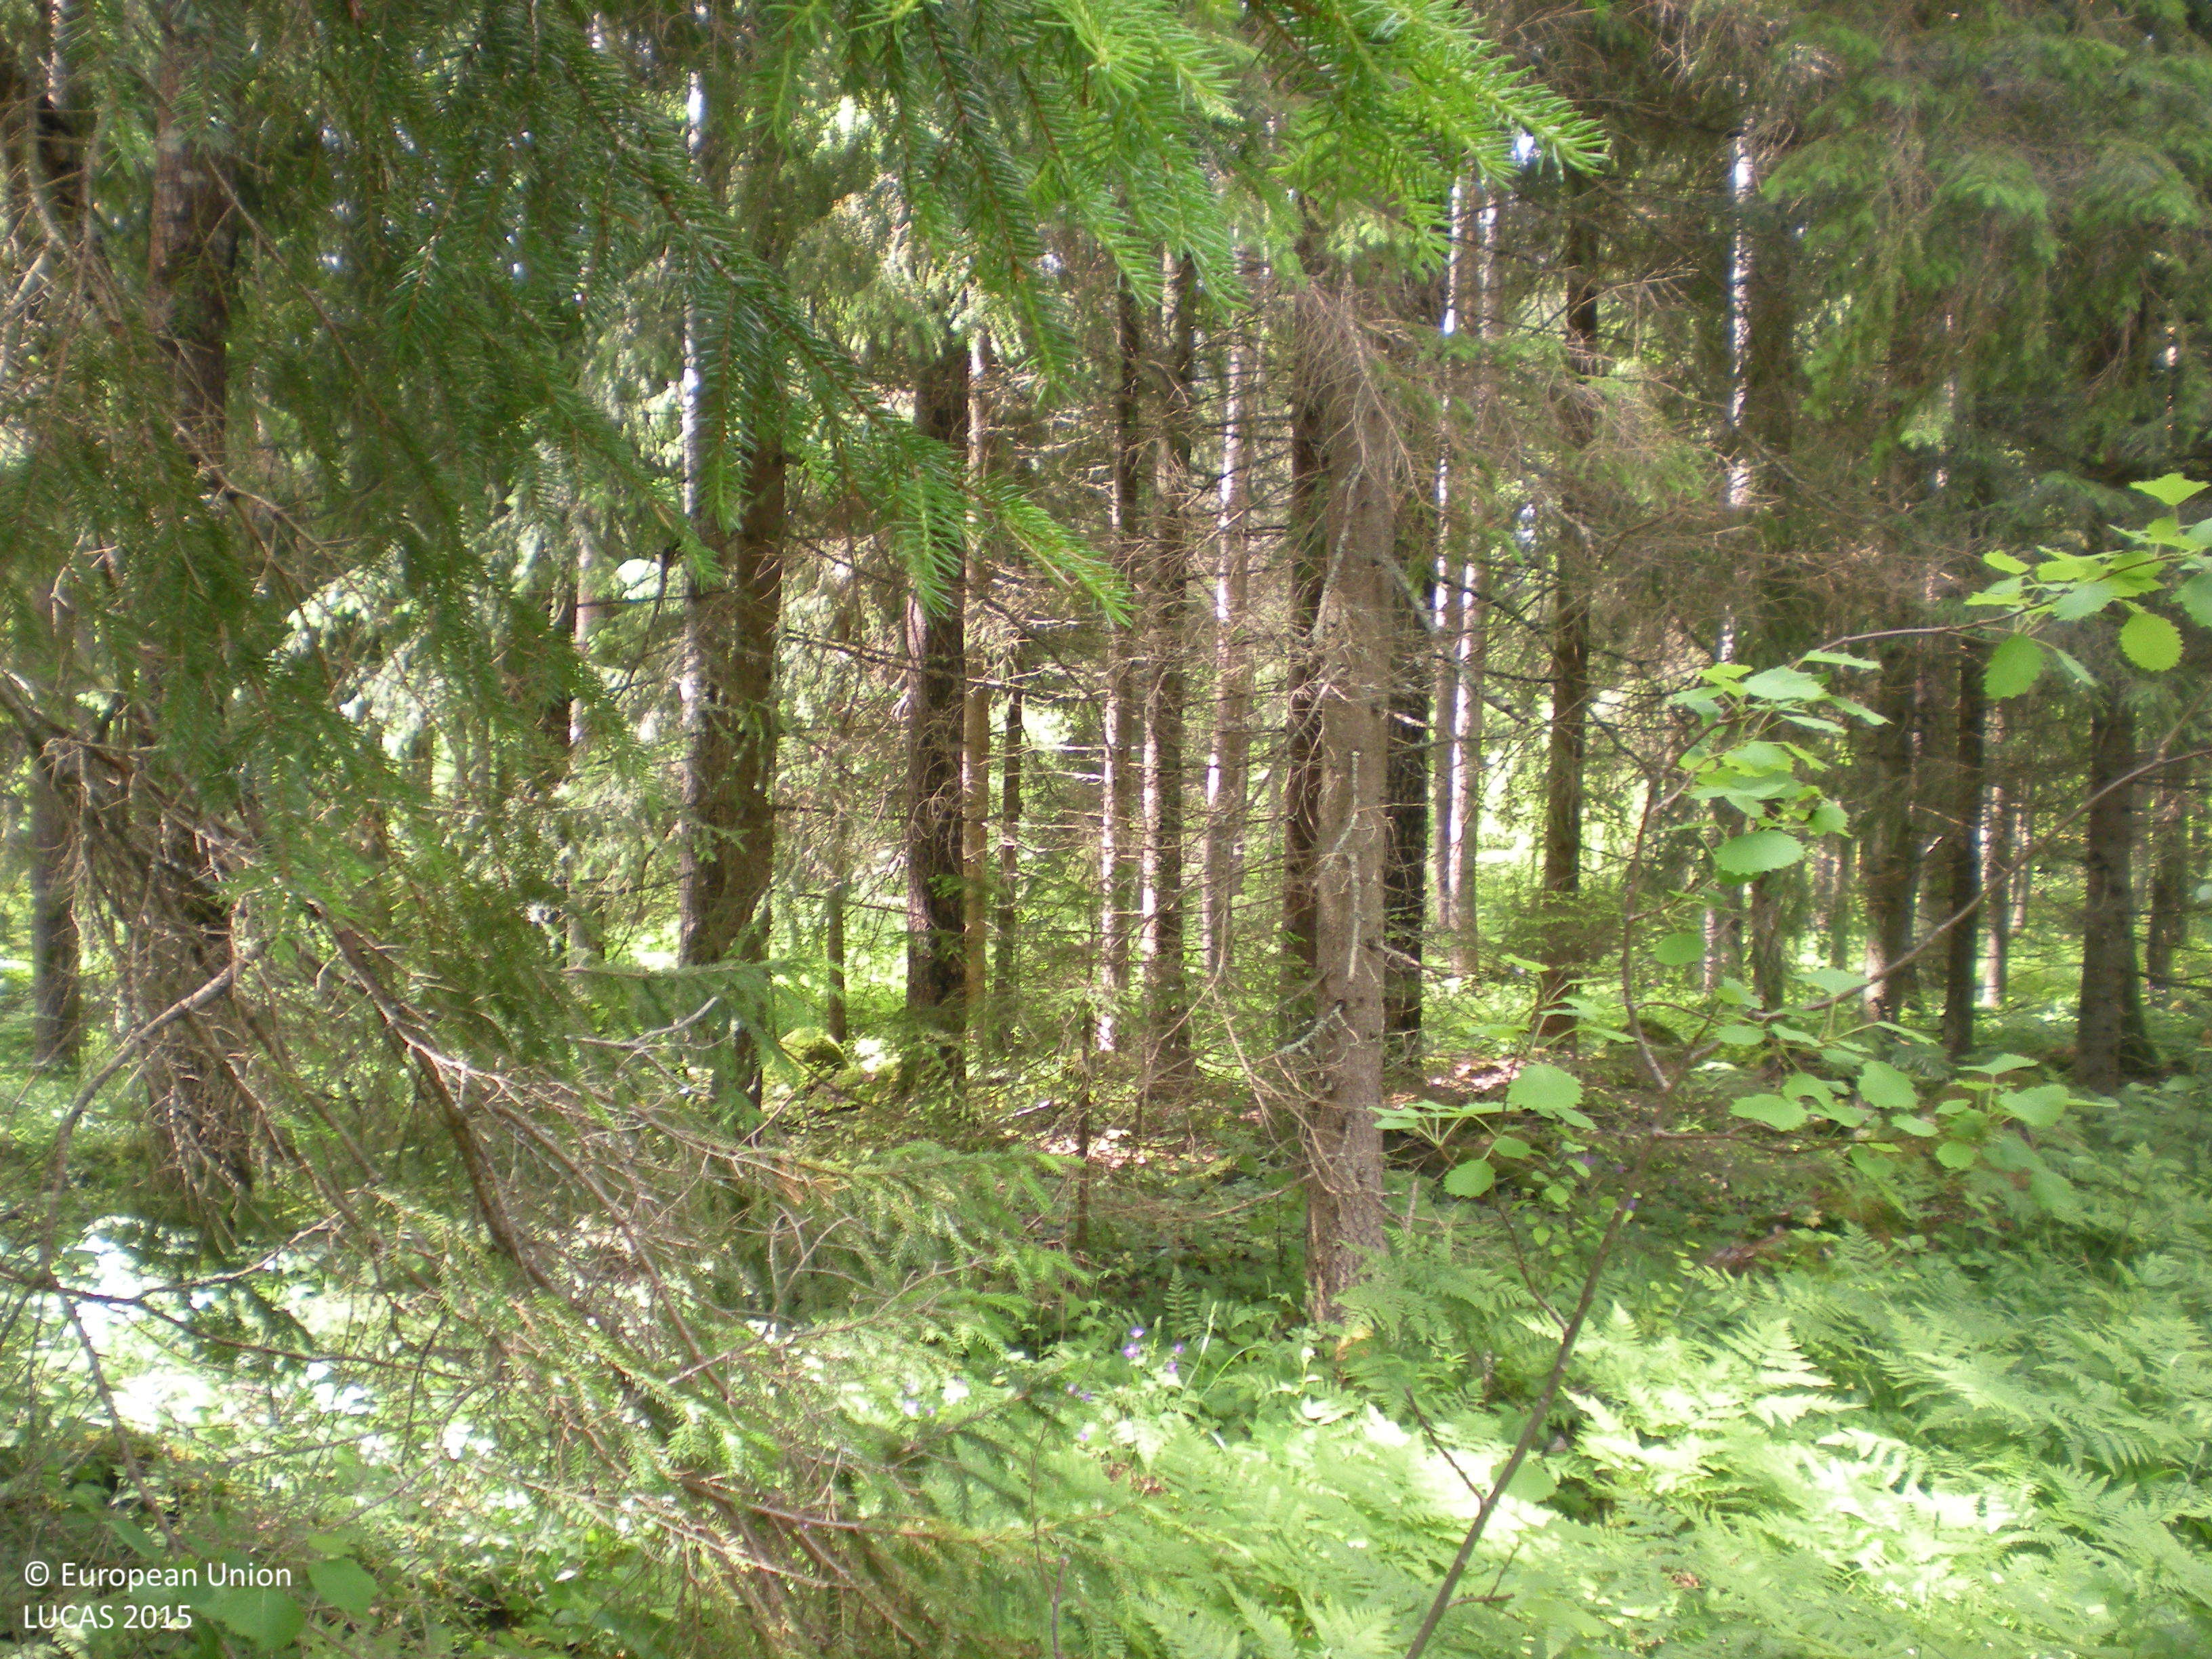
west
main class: Woodland
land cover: Spruce dominated coniferous woodland
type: boreal forest
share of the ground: 50 - 75 %
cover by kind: coniferous forest trees 60 %, herbaceous plants 20 %, broadleaved forest trees 10 %, shrubs 10 %
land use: Forestry
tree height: > 5 m
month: June
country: SE
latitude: 60.4181
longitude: 17.7828
